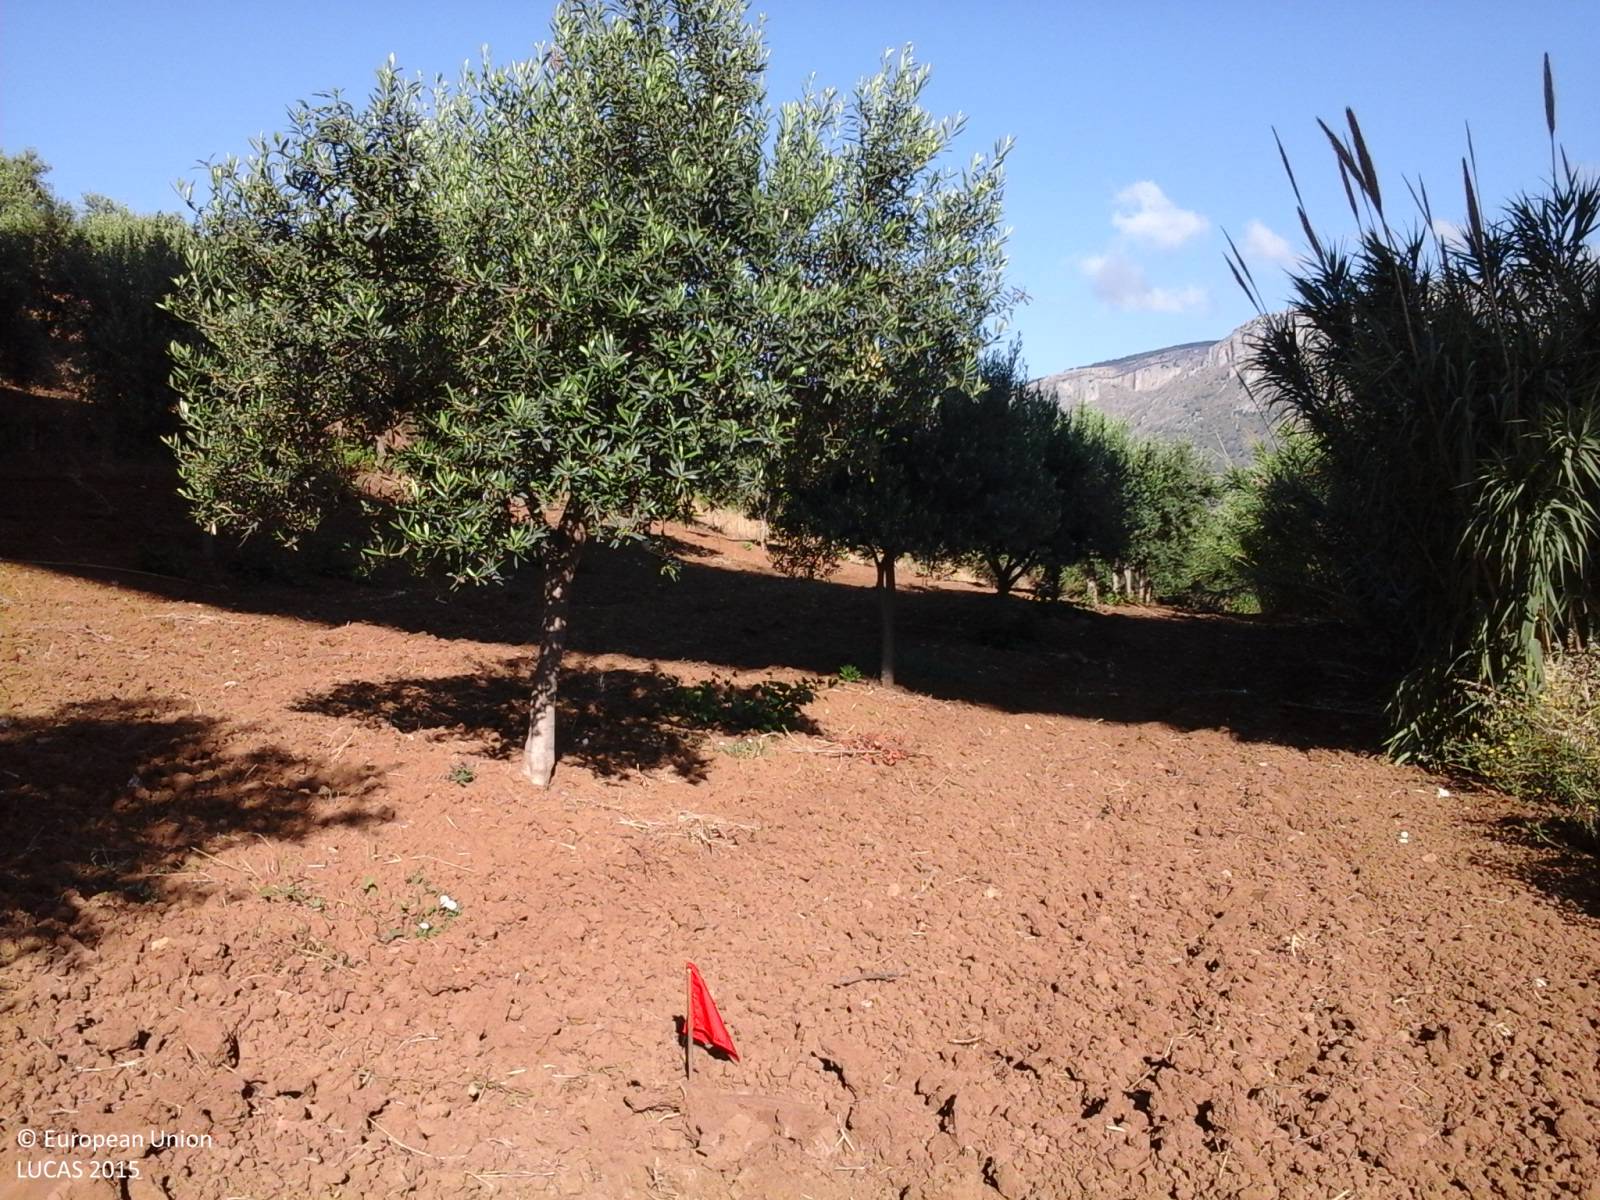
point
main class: Cropland
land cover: Olive groves
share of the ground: 25 - 50 %
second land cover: Other bare soil
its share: > 75 %
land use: Agriculture (excluding fallow land and kitchen gardens)
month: June
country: IT
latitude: 37.9749
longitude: 12.9273
